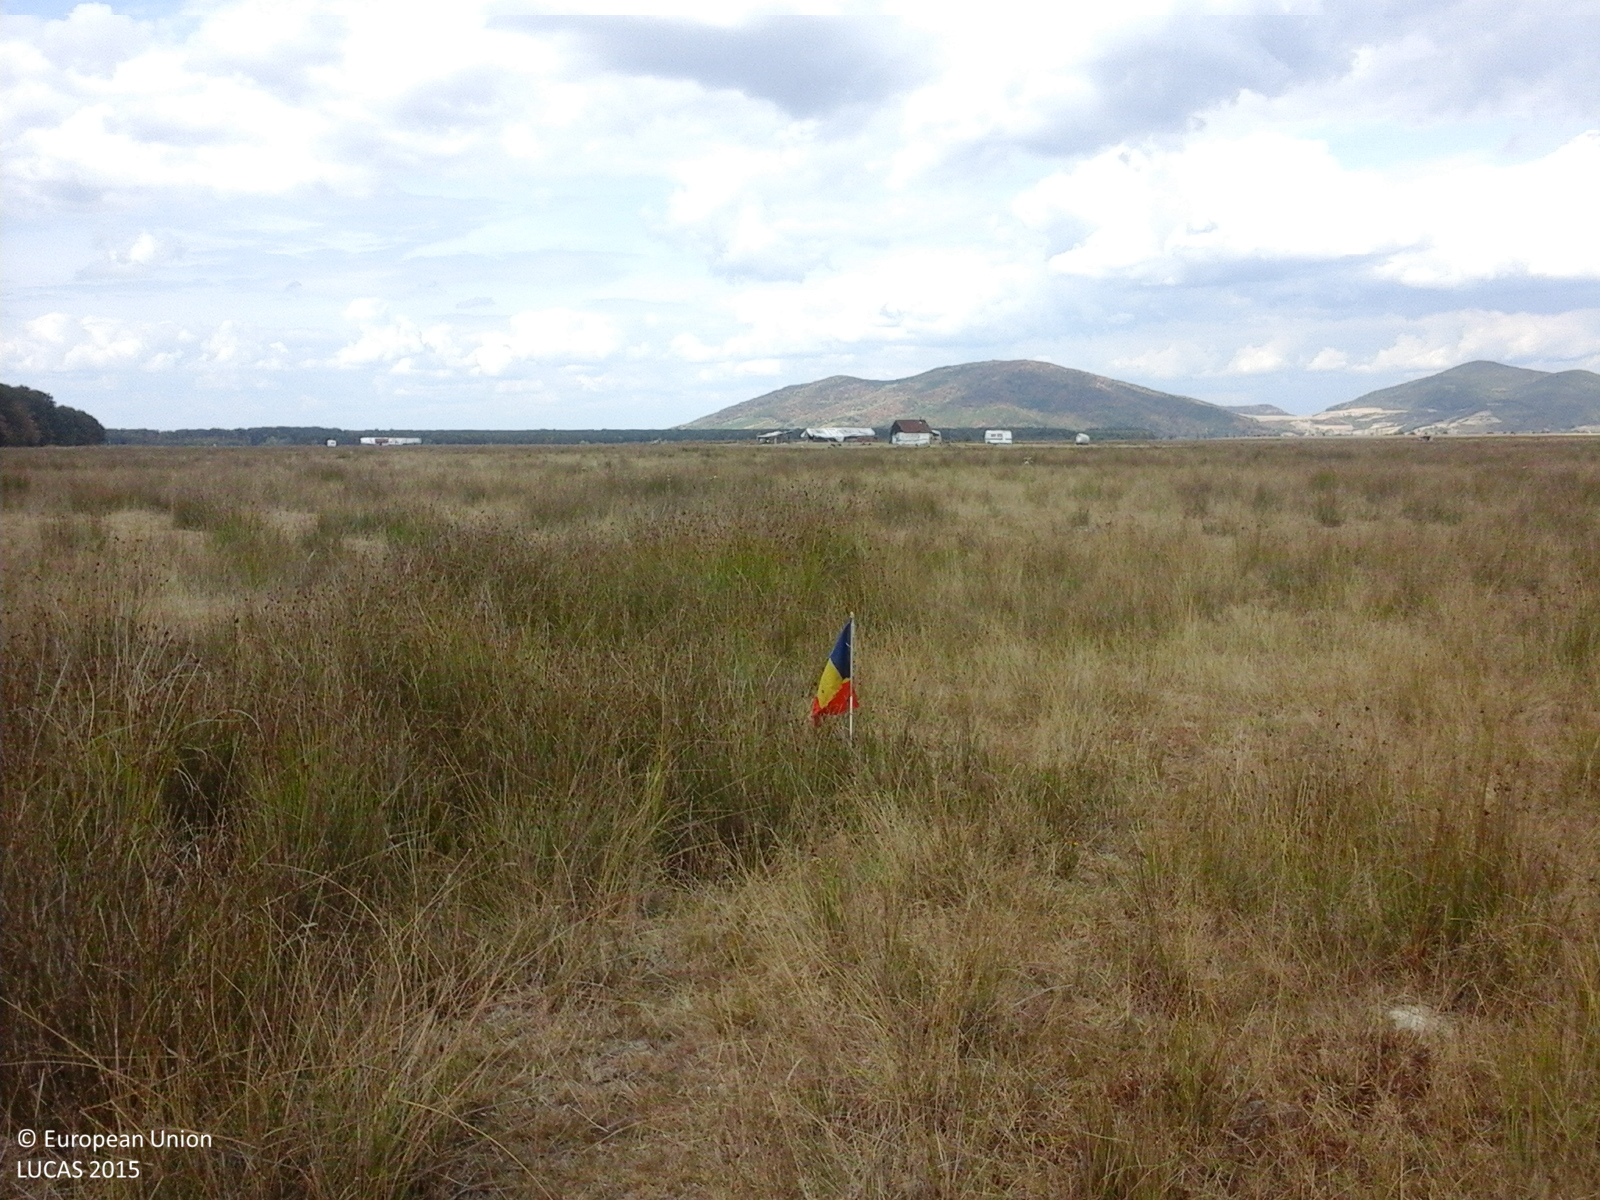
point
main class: Grassland
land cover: Grassland without tree/shrub cover
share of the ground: > 75 %
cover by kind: herbaceous plants 100 %
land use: Agriculture (excluding fallow land and kitchen gardens)
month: September
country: RO
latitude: 47.8827
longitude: 23.1887
